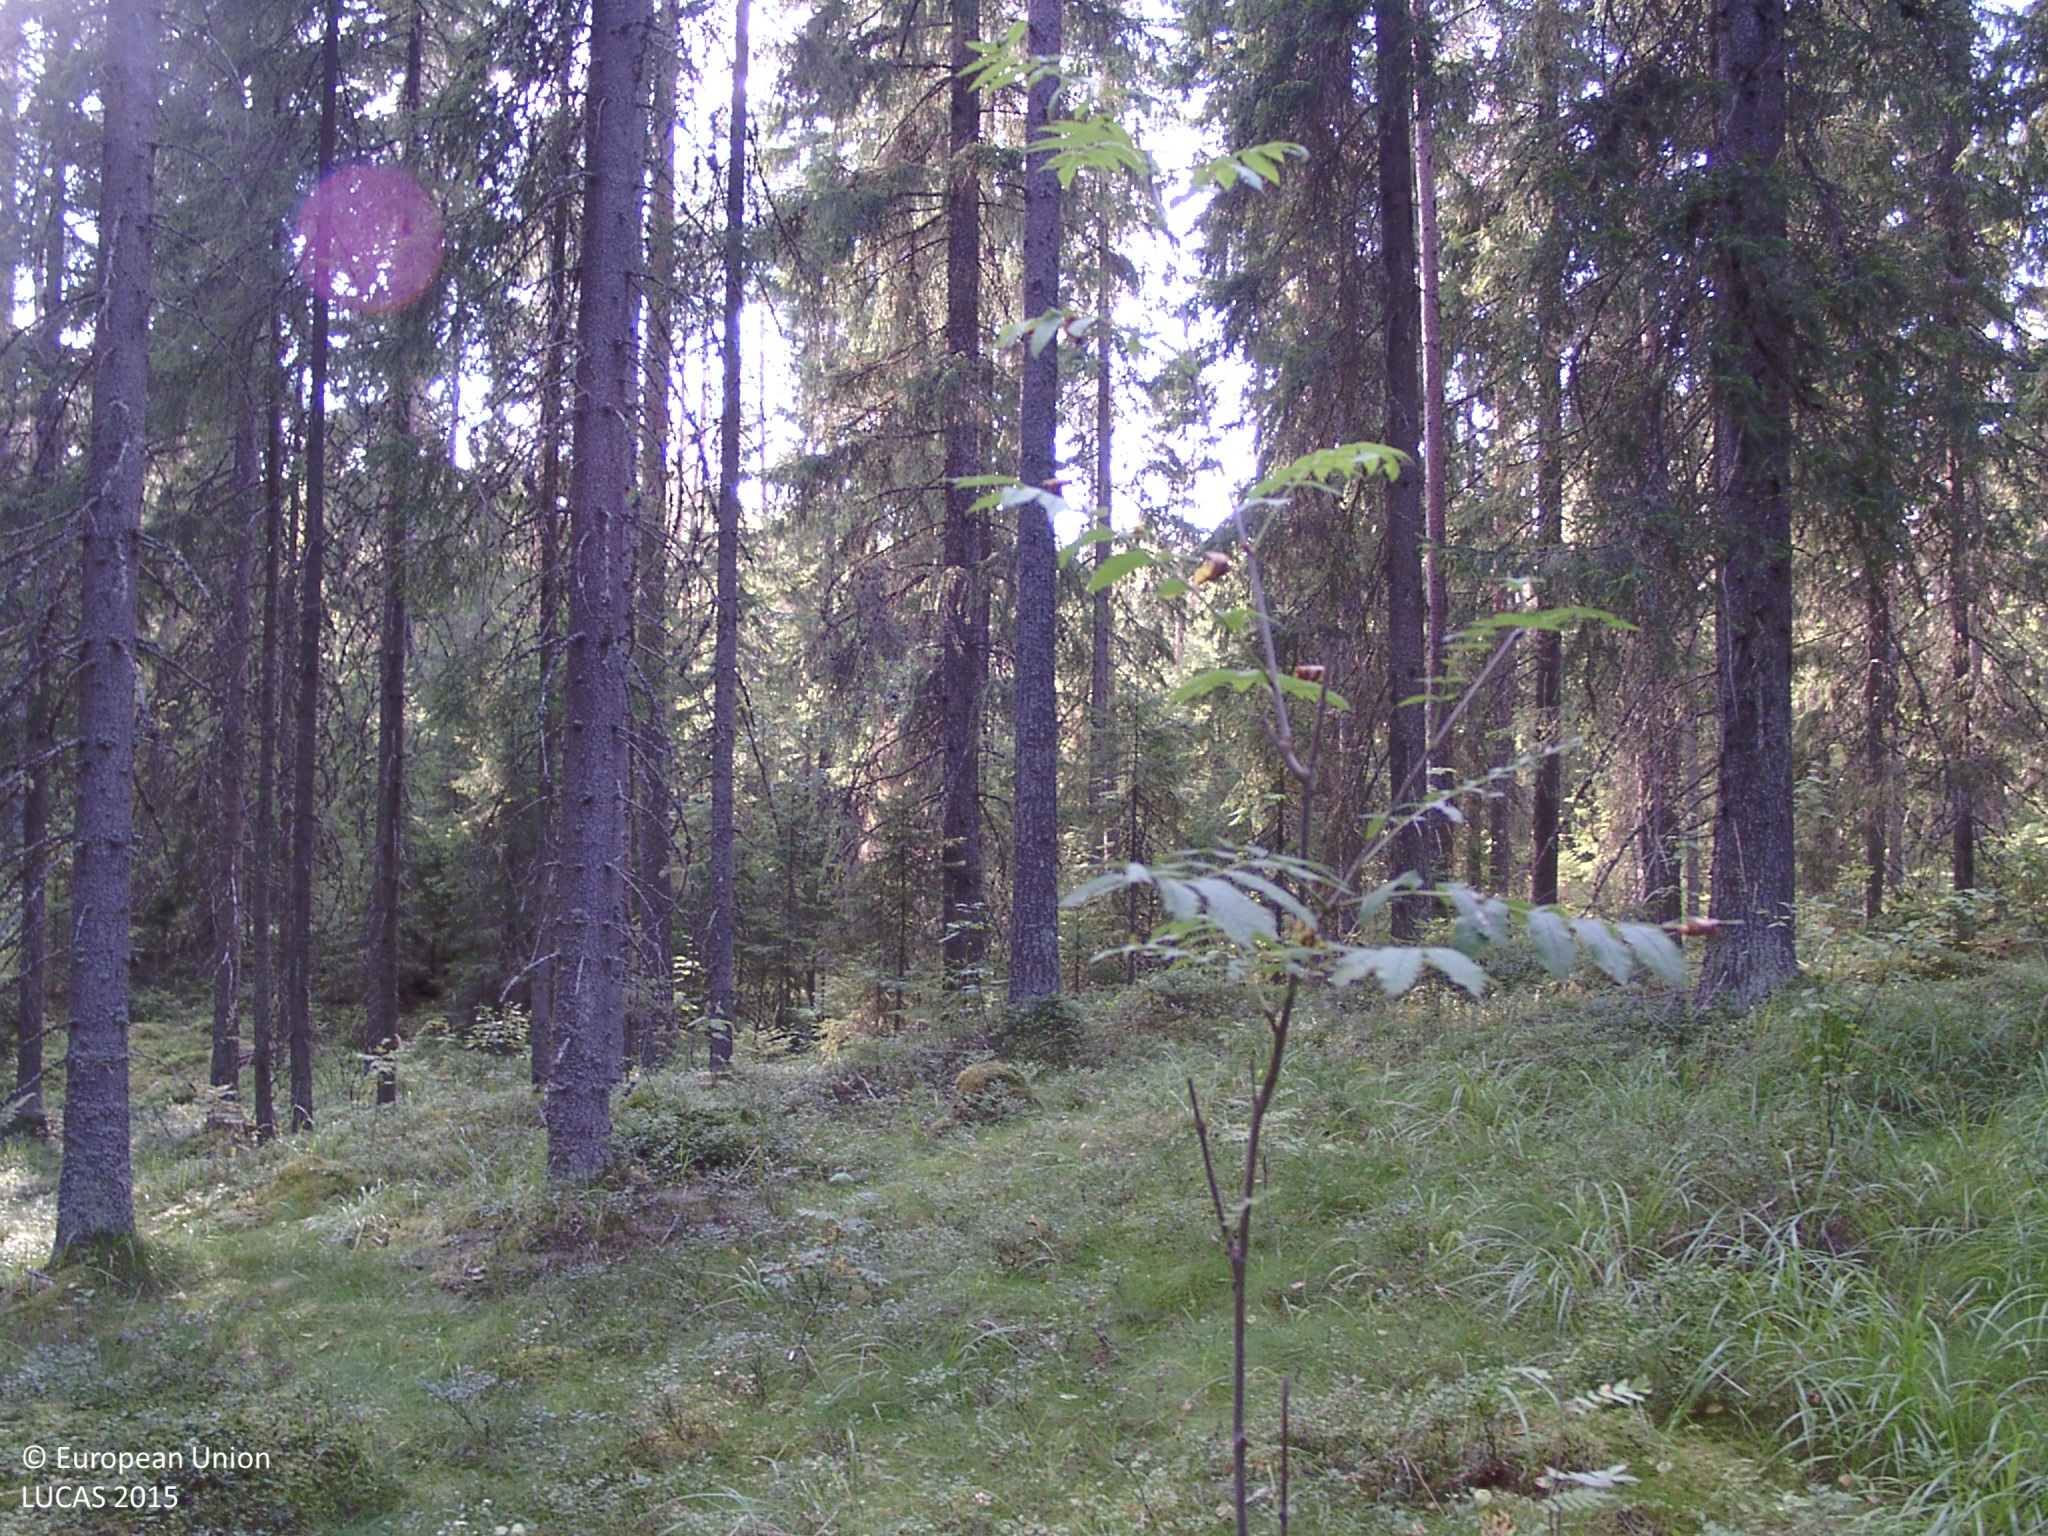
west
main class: Woodland
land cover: Other coniferous woodland
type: boreal forest
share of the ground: 50 - 75 %
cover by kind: coniferous forest trees 65 %, lichens and mosses 15 %, shrubs 10 %, broadleaved forest trees 5 %, herbaceous plants 5 %
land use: Forestry
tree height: > 5 m
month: August
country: FI
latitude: 61.7508
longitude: 24.9353
